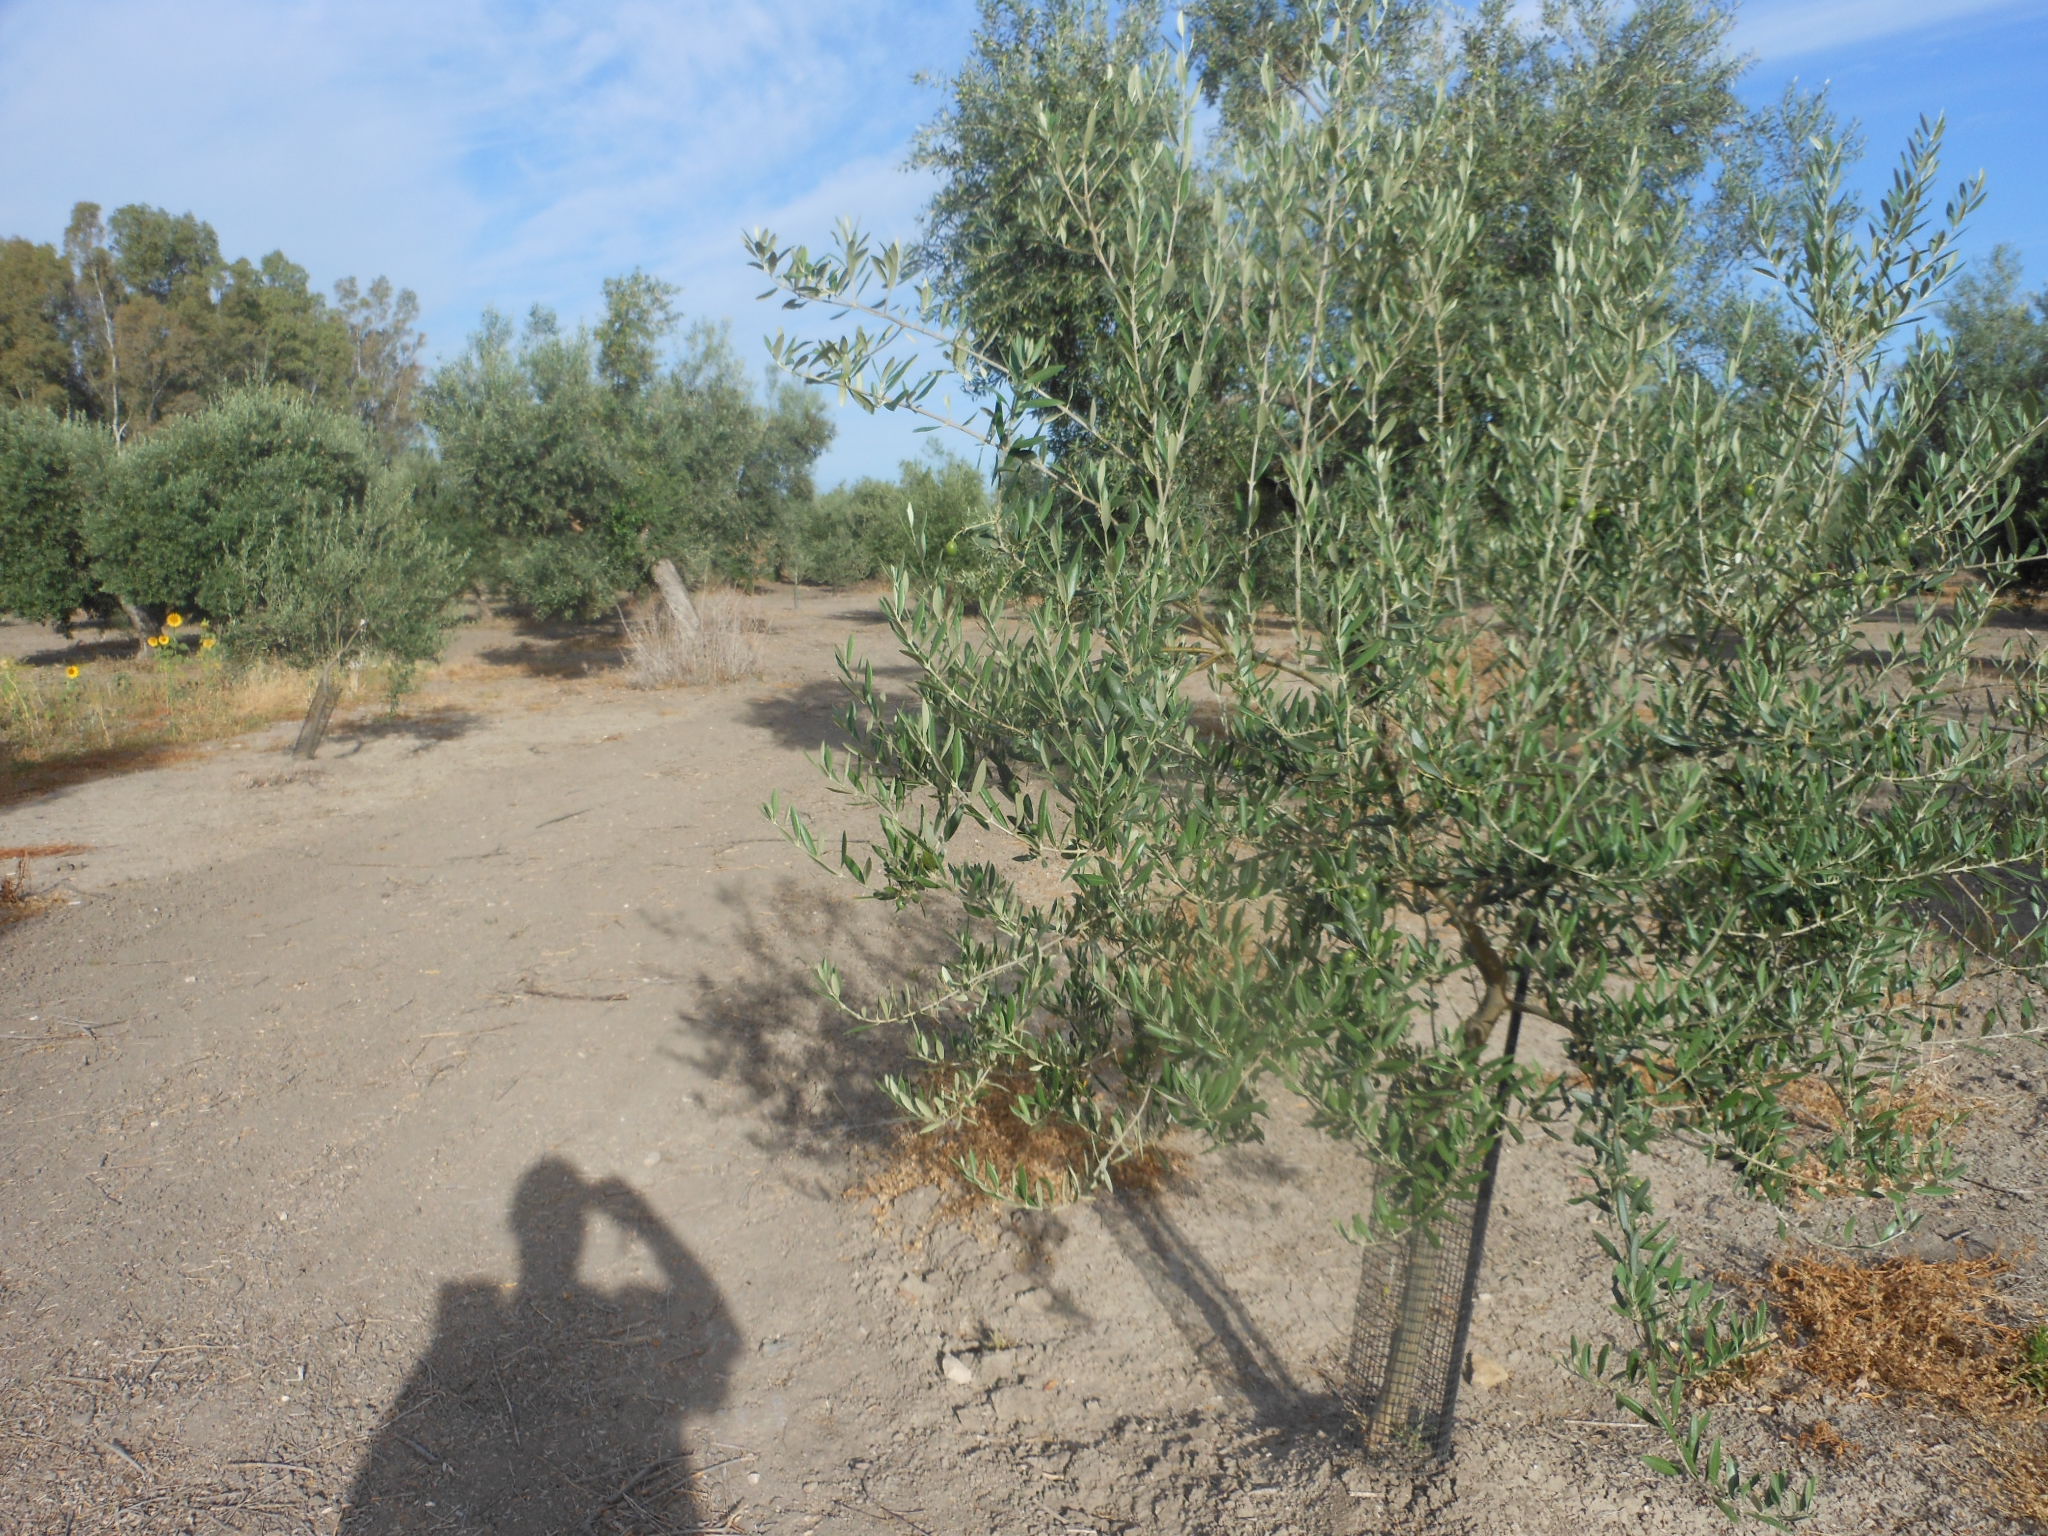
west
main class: Cropland
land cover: Olive groves
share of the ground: 50 - 75 %
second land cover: Other bare soil
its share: > 75 %
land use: Agriculture (excluding fallow land and kitchen gardens)
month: June
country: ES
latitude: 37.2362
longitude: -5.5352
